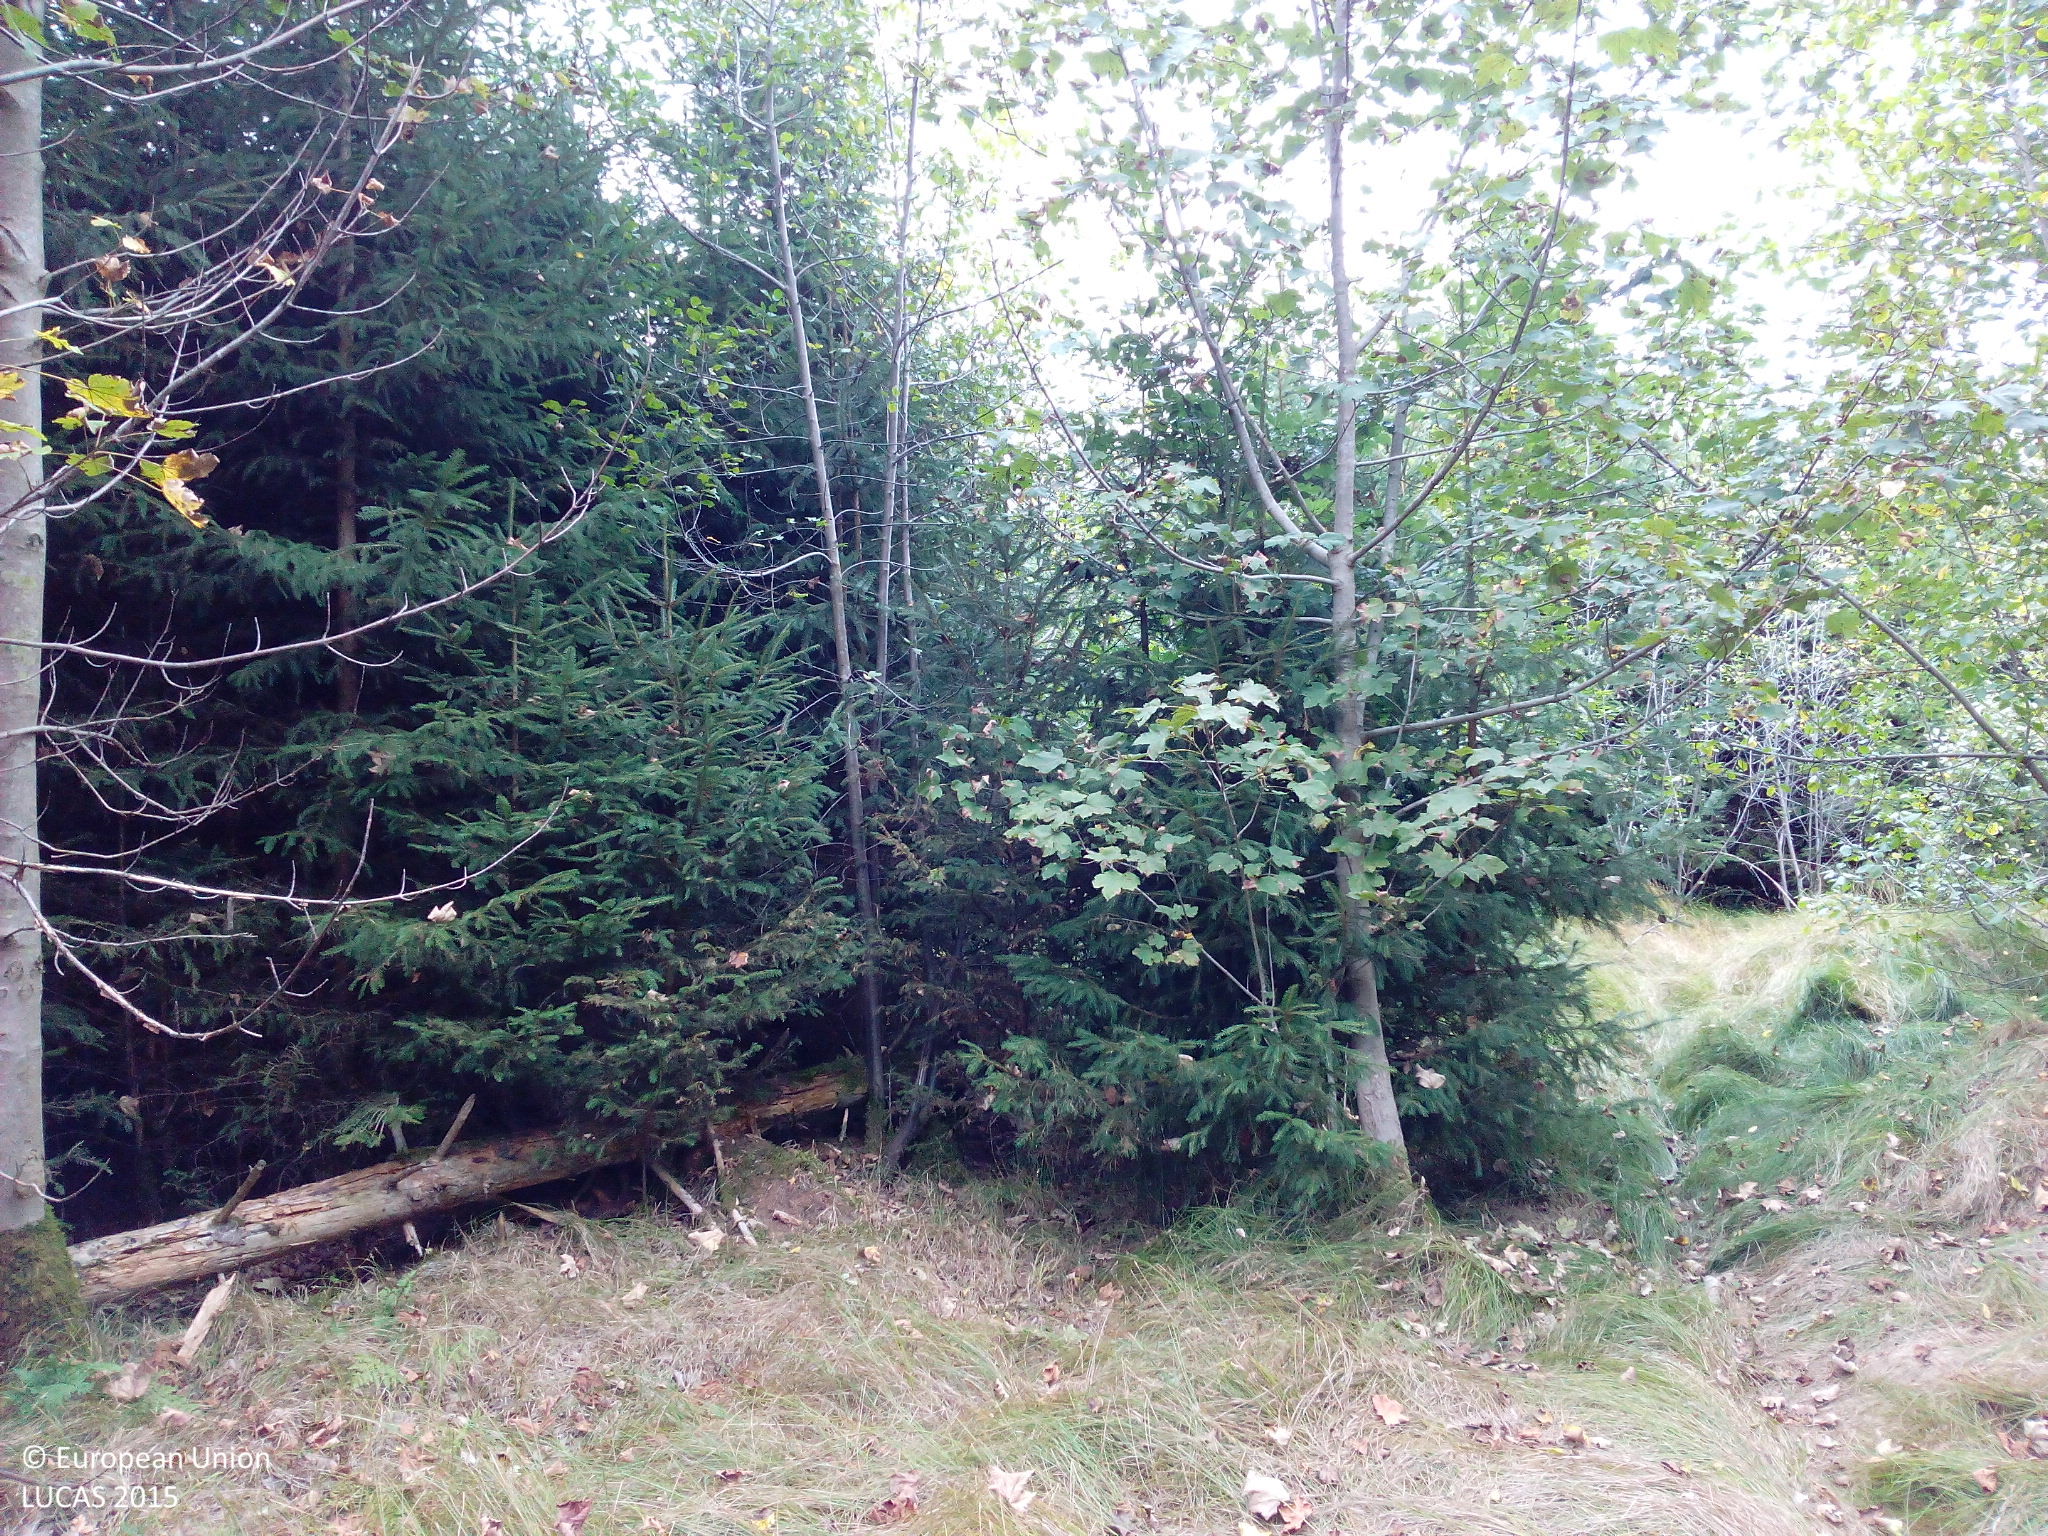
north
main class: Woodland
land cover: Broadleaved woodland
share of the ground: 50 - 75 %
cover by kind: broadleaved forest trees 60 %, herbaceous plants 40 %
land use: Forestry
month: September
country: DE
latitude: 48.3312
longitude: 10.2561
